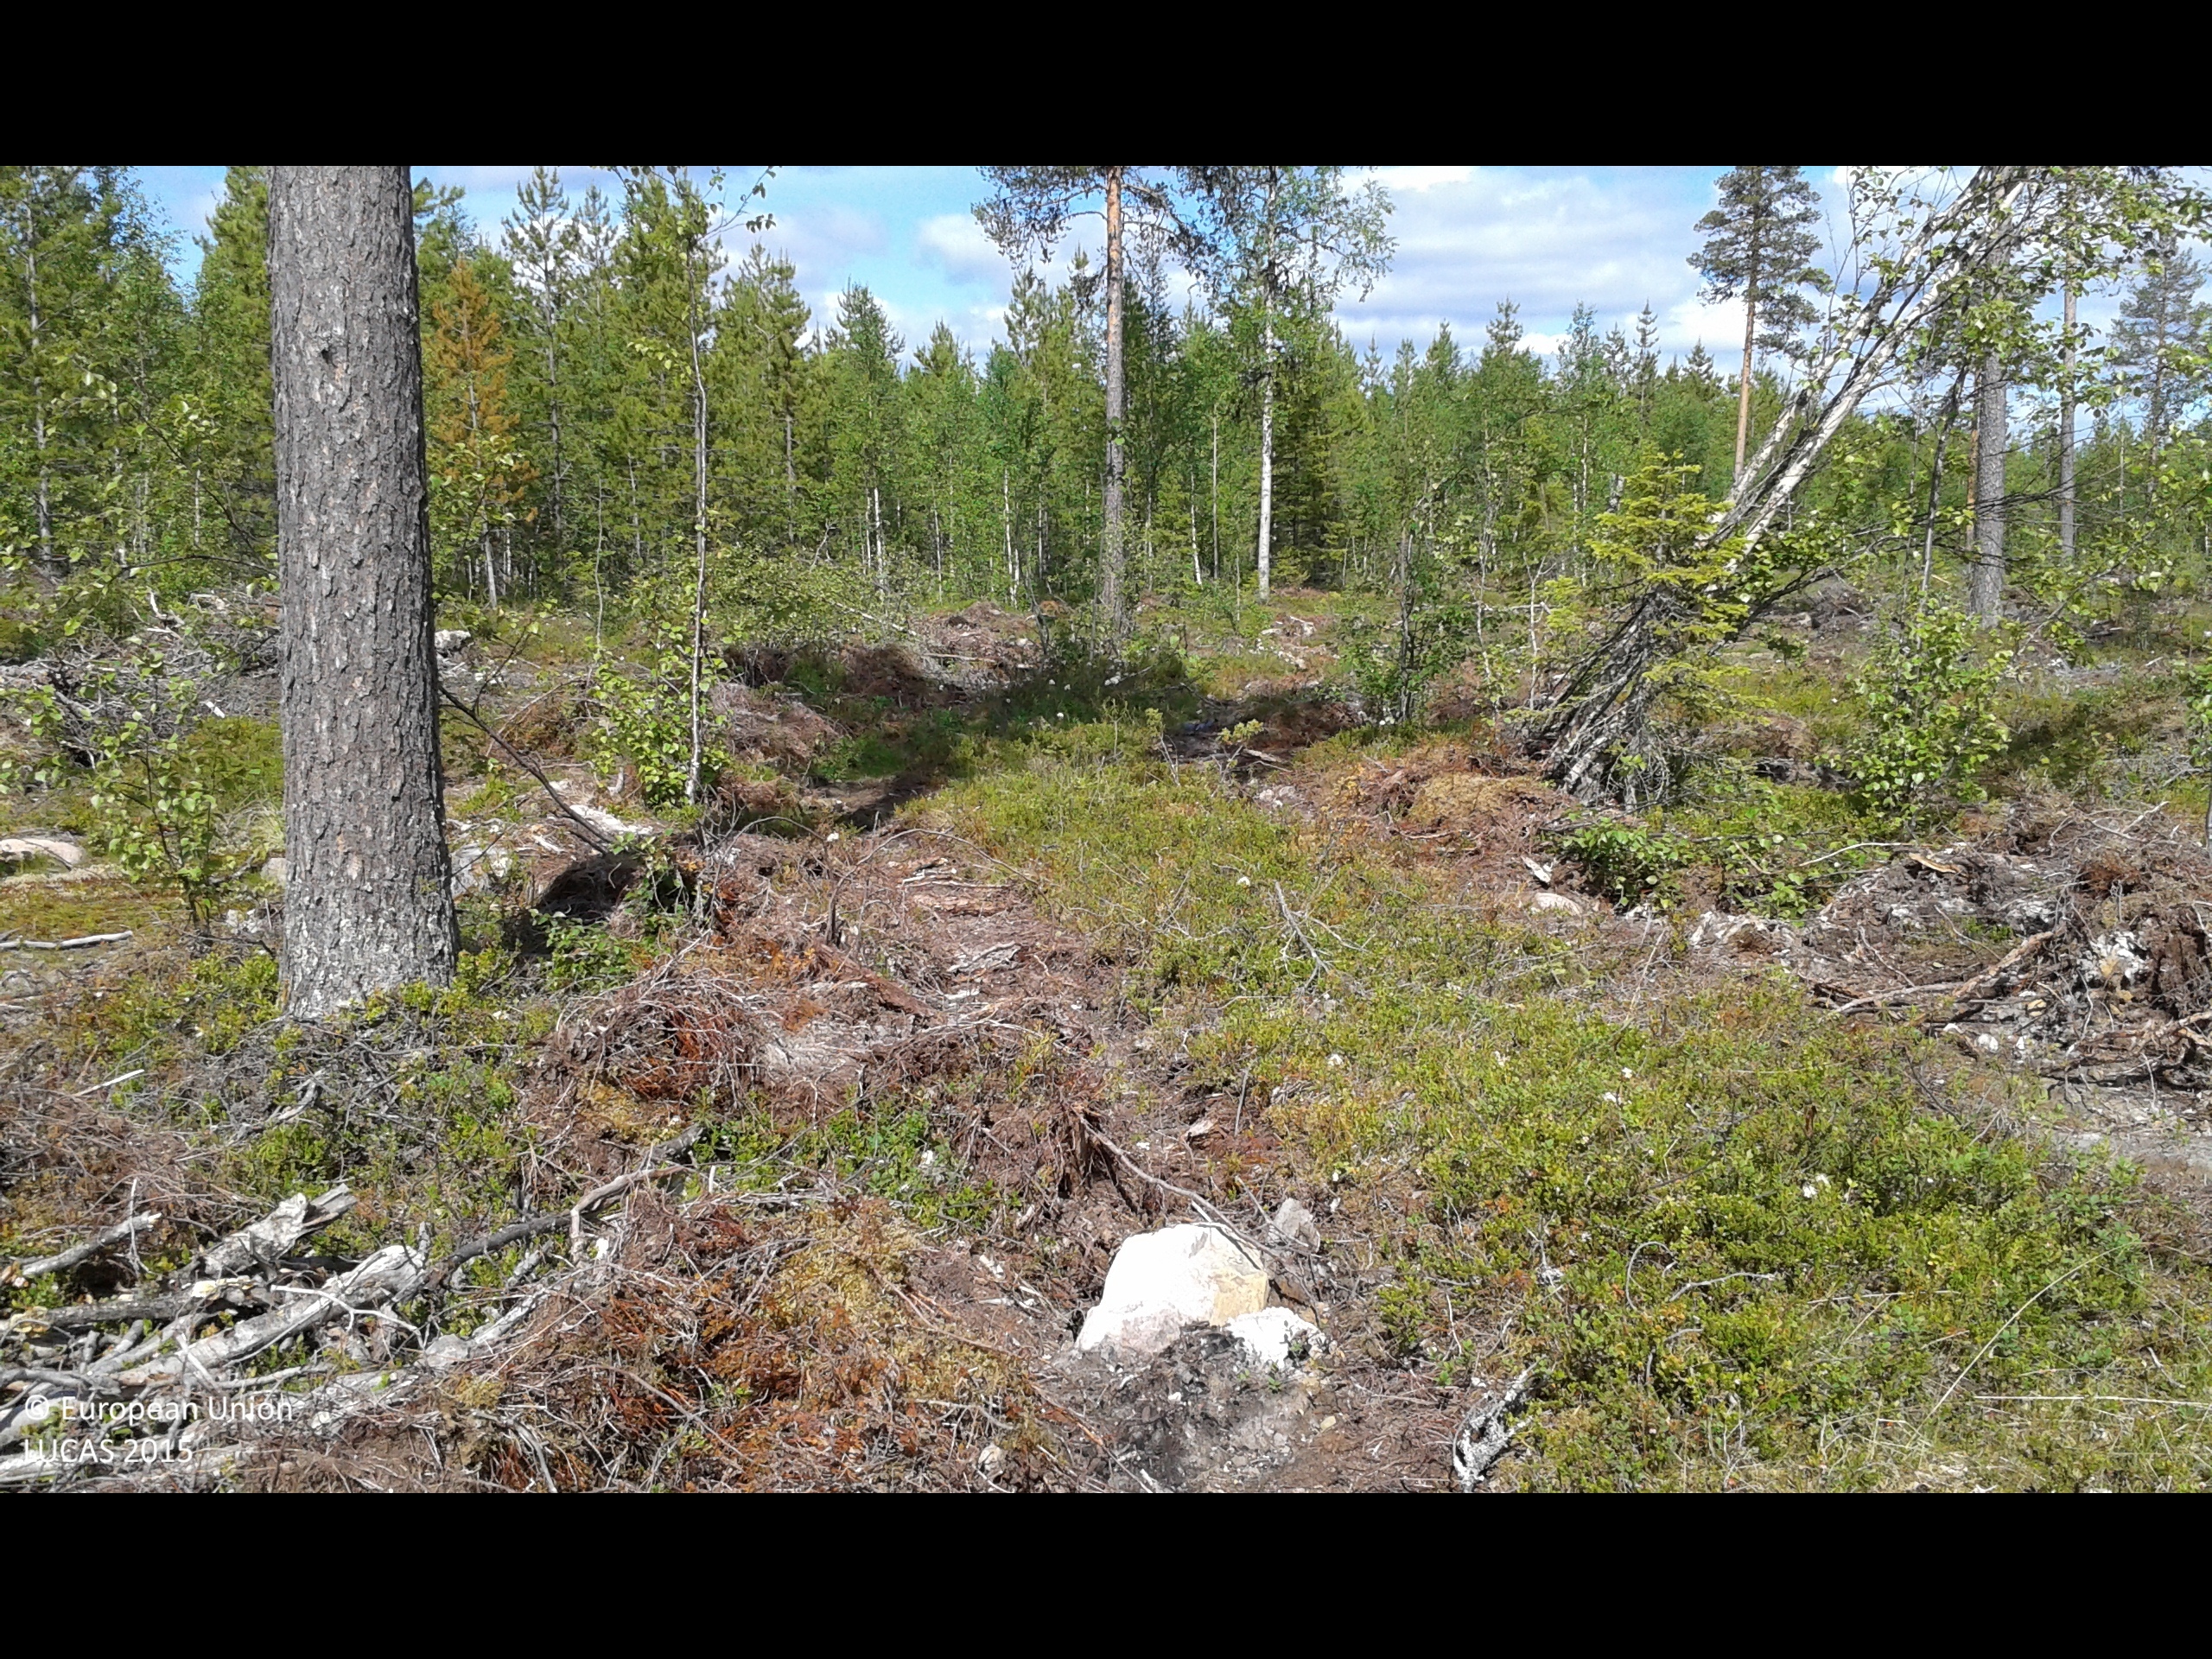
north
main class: Woodland
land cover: Pine dominated mixed woodland
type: boreal forest
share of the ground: 10 - 25 %
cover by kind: unconsolidated bare surface 50 %, shrubs 35 %, coniferous forest trees 10 %, broadleaved forest trees 5 %
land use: Forestry
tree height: > 5 m
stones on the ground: < 10 %
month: July
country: SE
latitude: 67.0349
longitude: 23.0854
